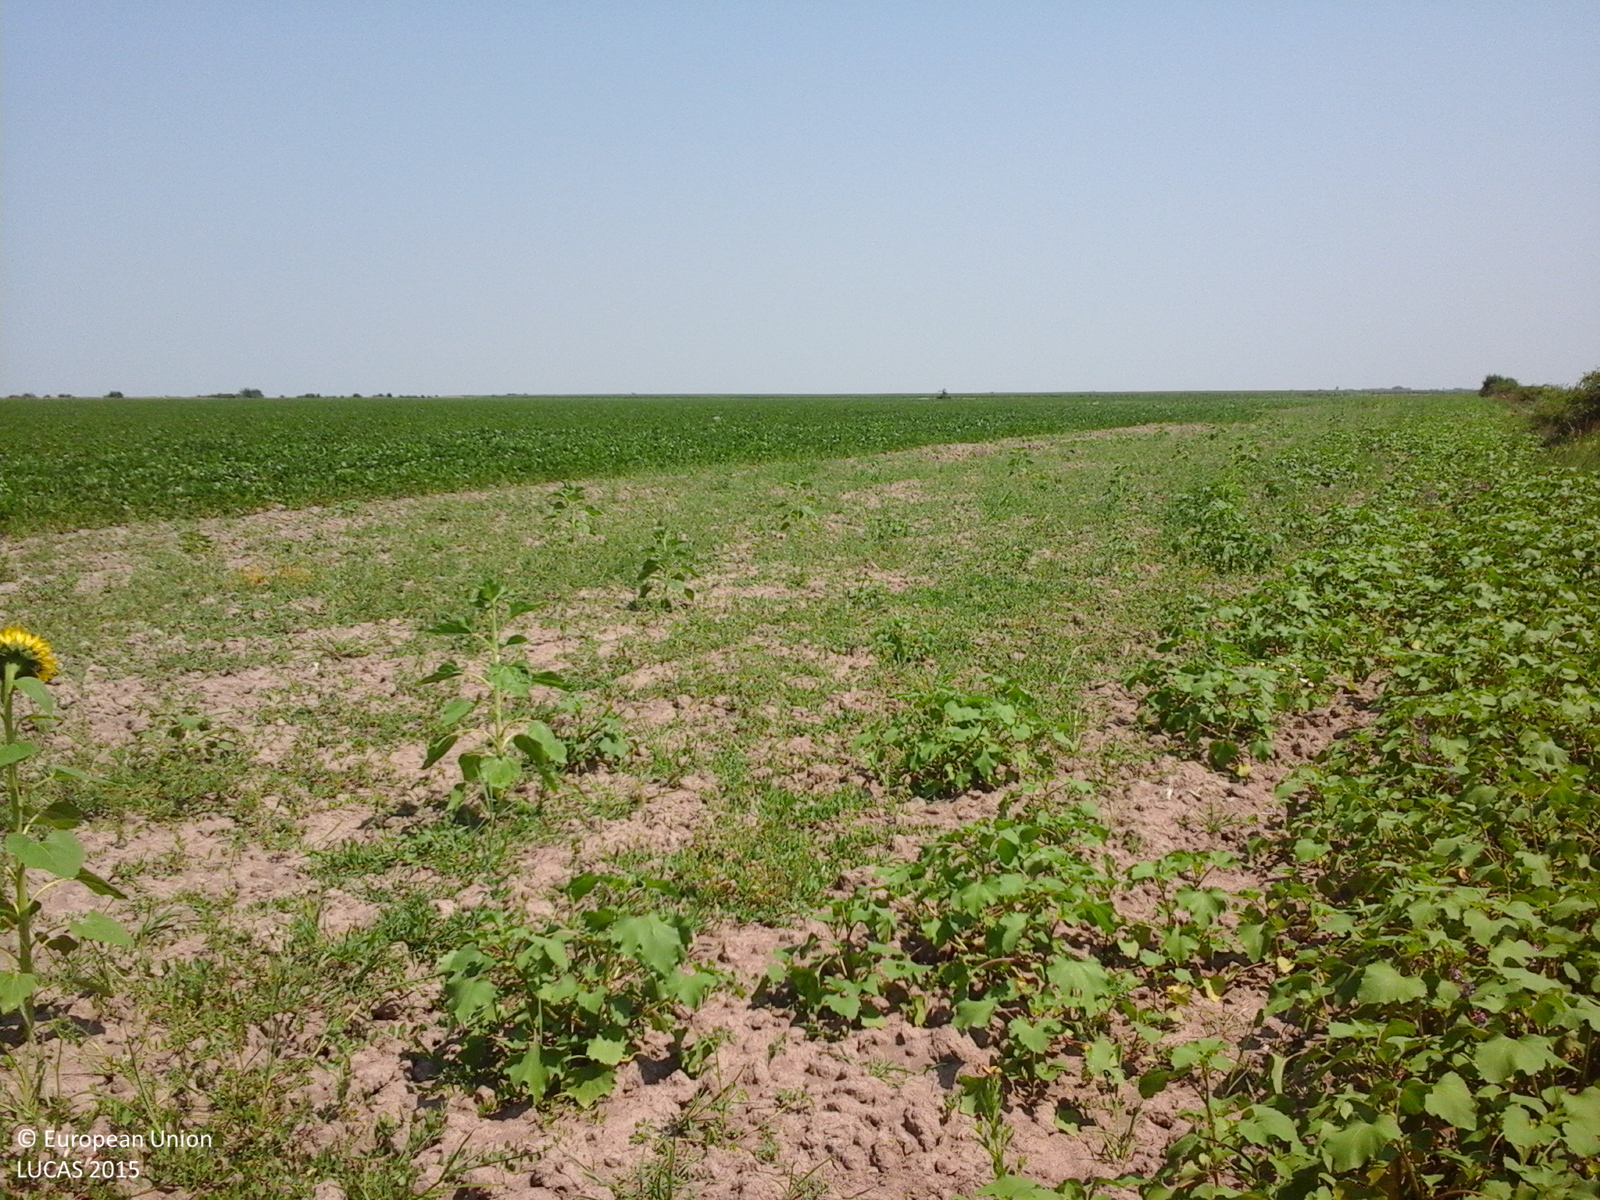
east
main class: Grassland
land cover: Spontaneously vegetated surfaces
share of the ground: > 75 %
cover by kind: herbaceous plants 100 %
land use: Fallow land
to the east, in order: Spontaneously vegetated surfaces; Soya
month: July
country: RO
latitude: 44.7720
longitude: 25.6267
